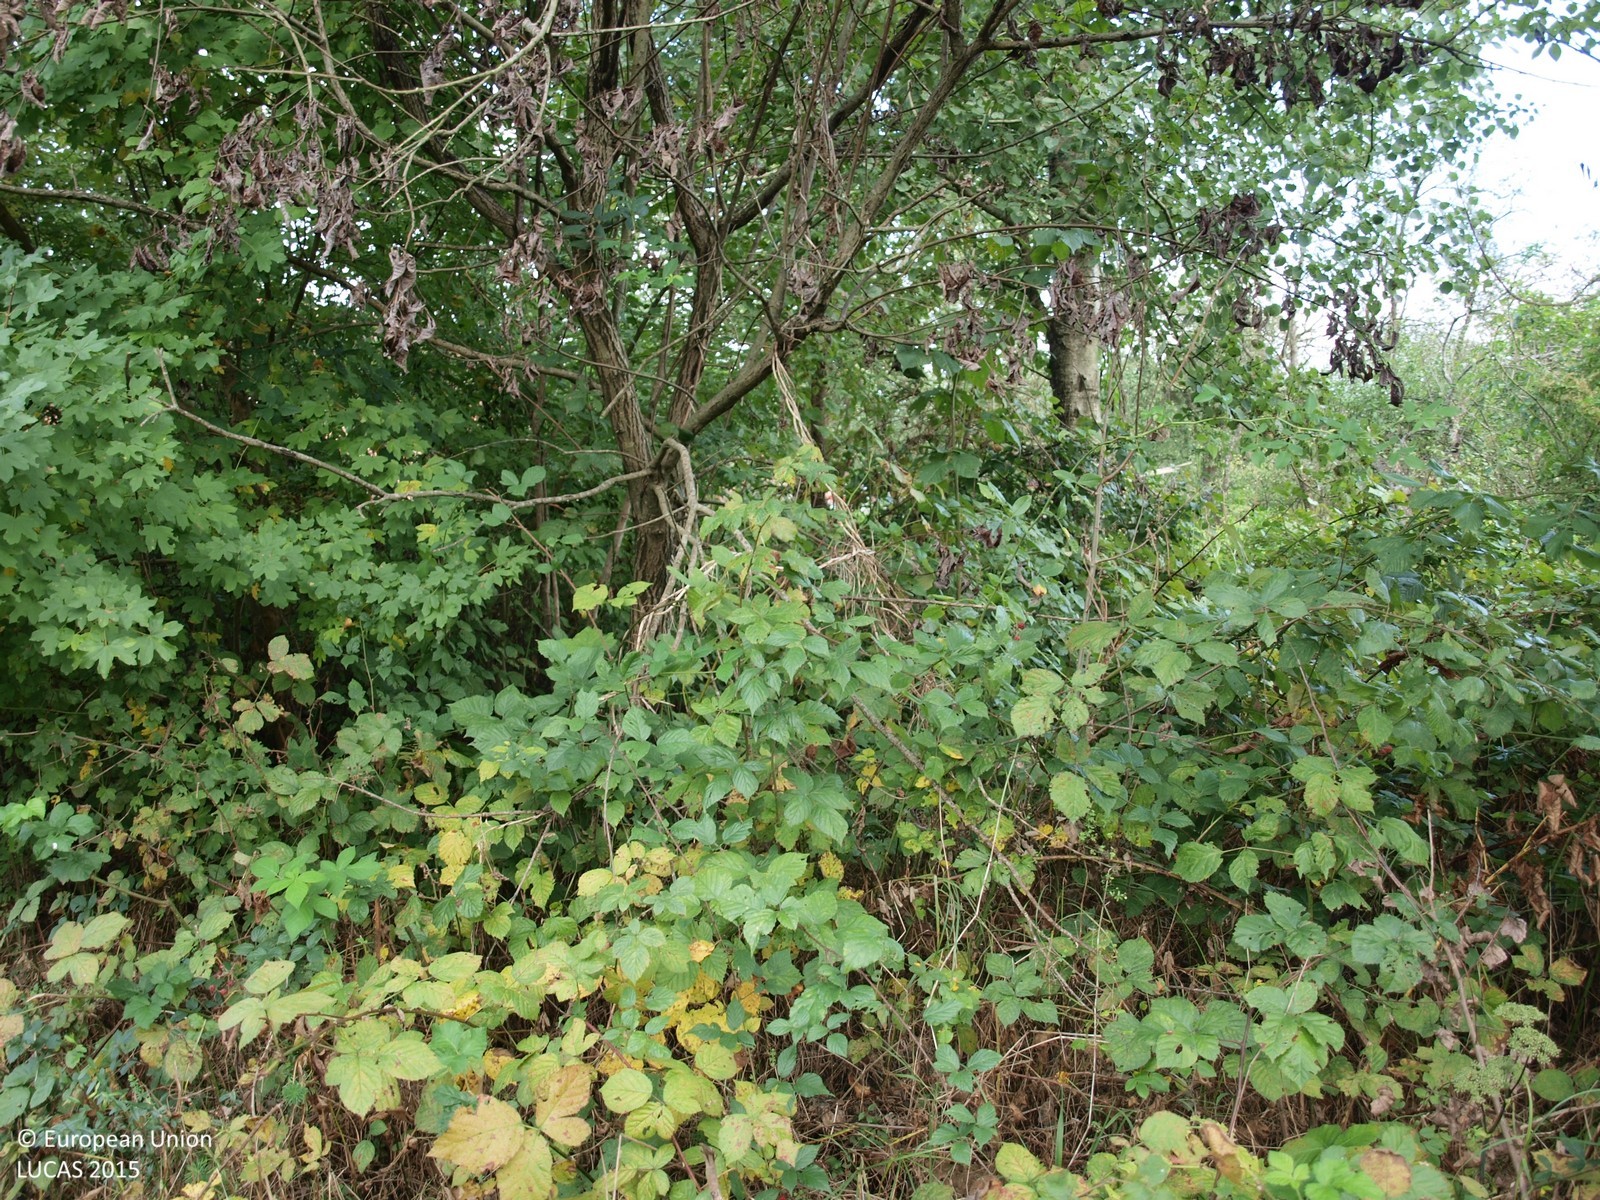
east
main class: Shrubland
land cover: Shrubland with sparse tree cover
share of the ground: > 75 %
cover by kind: shrubs 95 %, broadleaved forest trees 5 %
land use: Semi-natural and natural areas not in use
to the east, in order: Shrubland with sparse tree cover; Grassland without tree/shrub cover; Artificial constructions in urban areas; Abandoned hedges; Grassland without tree/shrub cover; Abandoned hedges; Grassland without tree/shrub cover
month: October
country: HR
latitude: 45.4532
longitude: 16.1222
